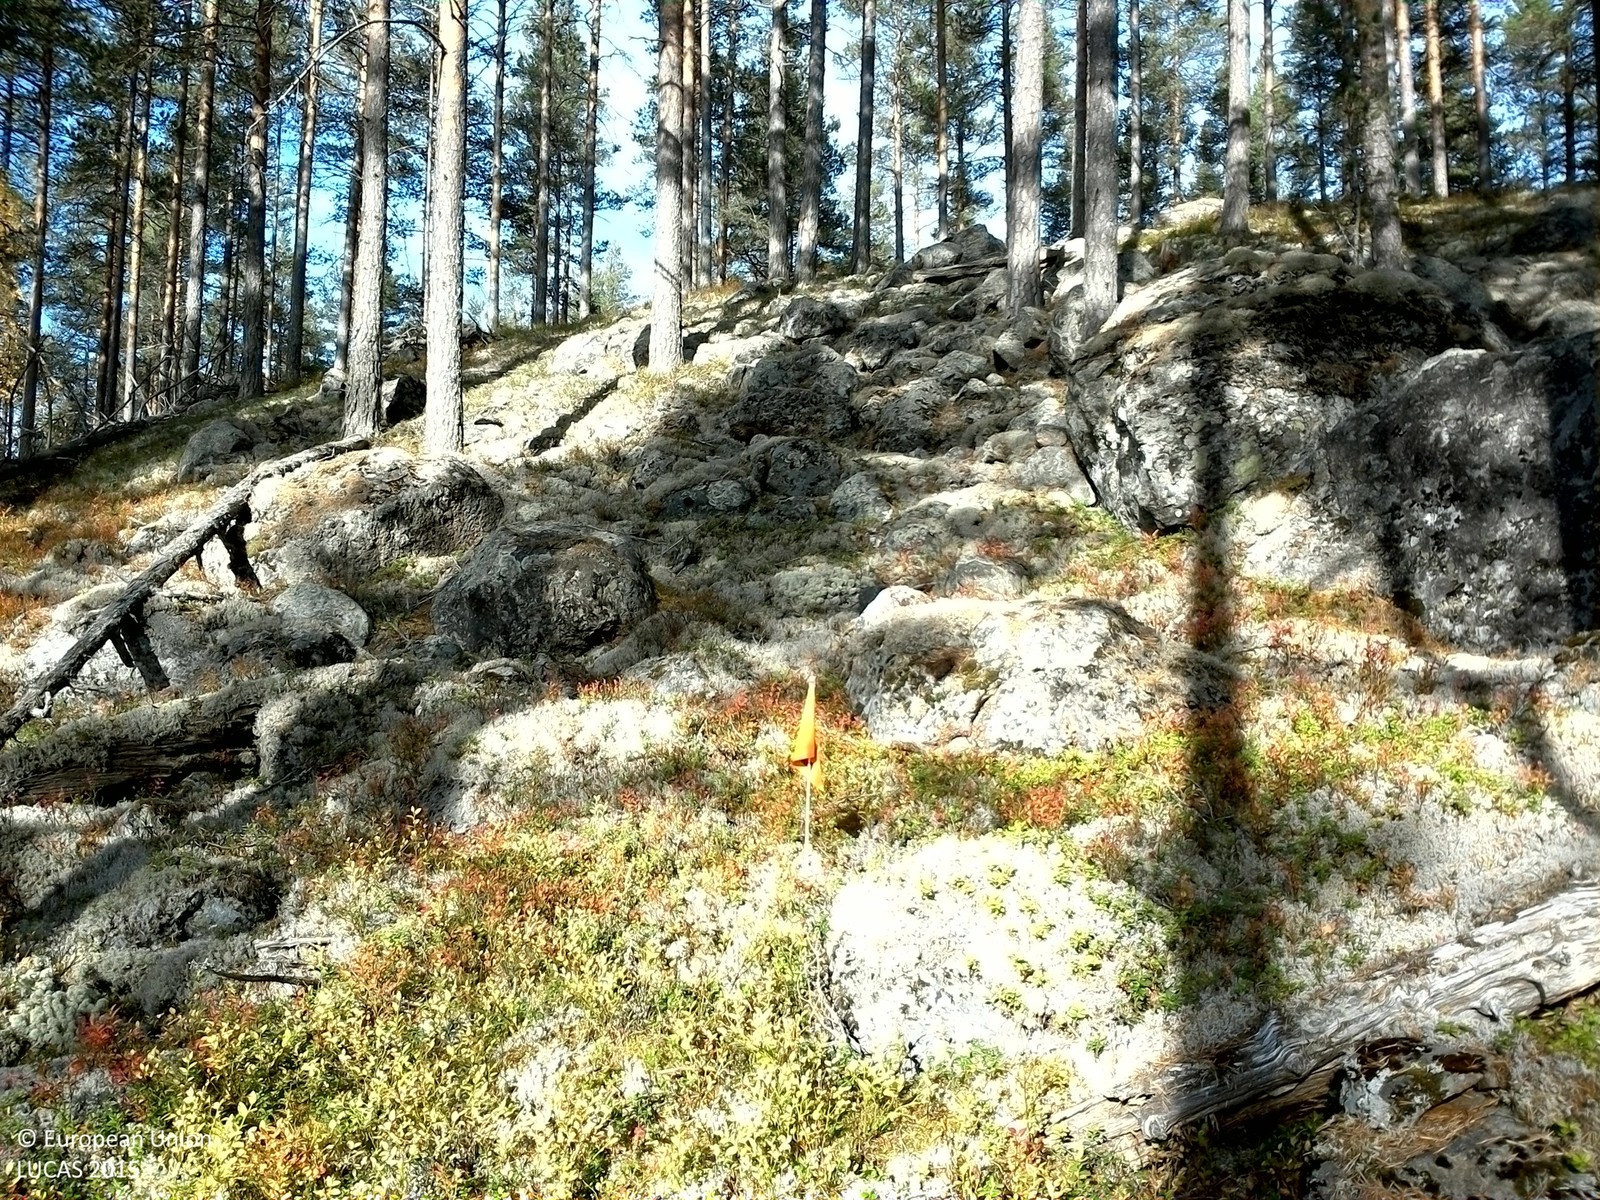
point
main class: Woodland
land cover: Pine dominated coniferous woodland
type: boreal forest
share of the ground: 25 - 50 %
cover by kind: coniferous forest trees 45 %, shrubs 25 %, consolidated bare surface 20 %, lichens and mosses 10 %
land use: Forestry
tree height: > 5 m
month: October
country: SE
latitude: 61.3869
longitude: 15.1323
